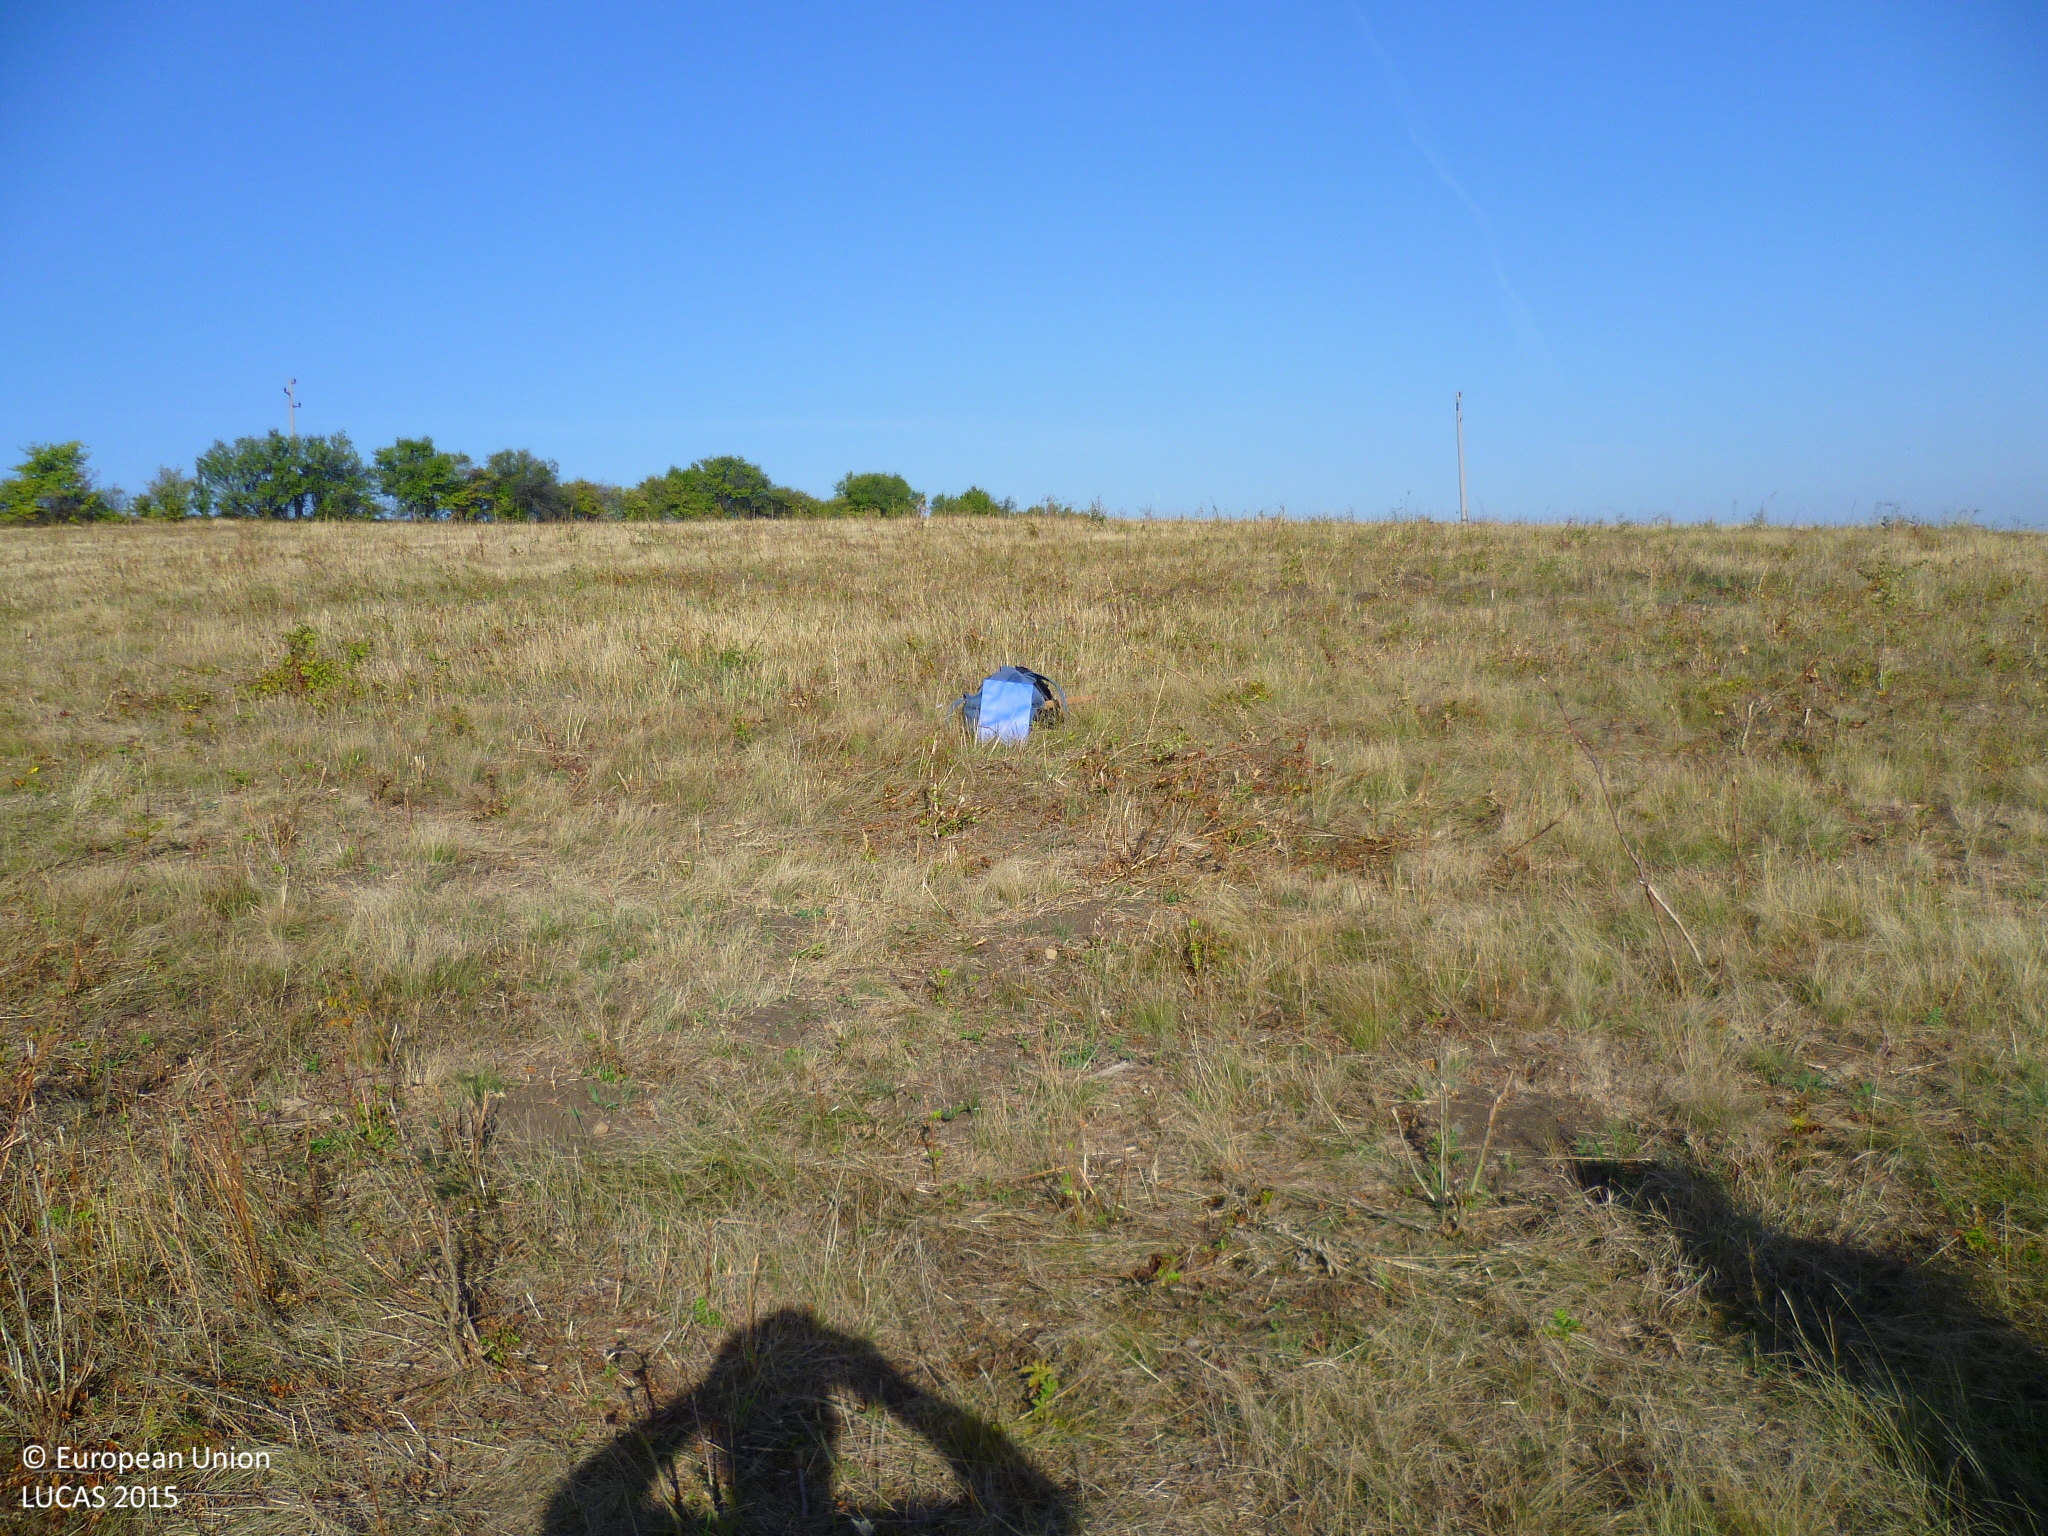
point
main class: Grassland
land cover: Grassland without tree/shrub cover
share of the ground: > 75 %
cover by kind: herbaceous plants 100 %
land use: Agriculture (excluding fallow land and kitchen gardens)
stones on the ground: < 10 %
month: September
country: BG
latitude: 42.7533
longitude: 23.0678
